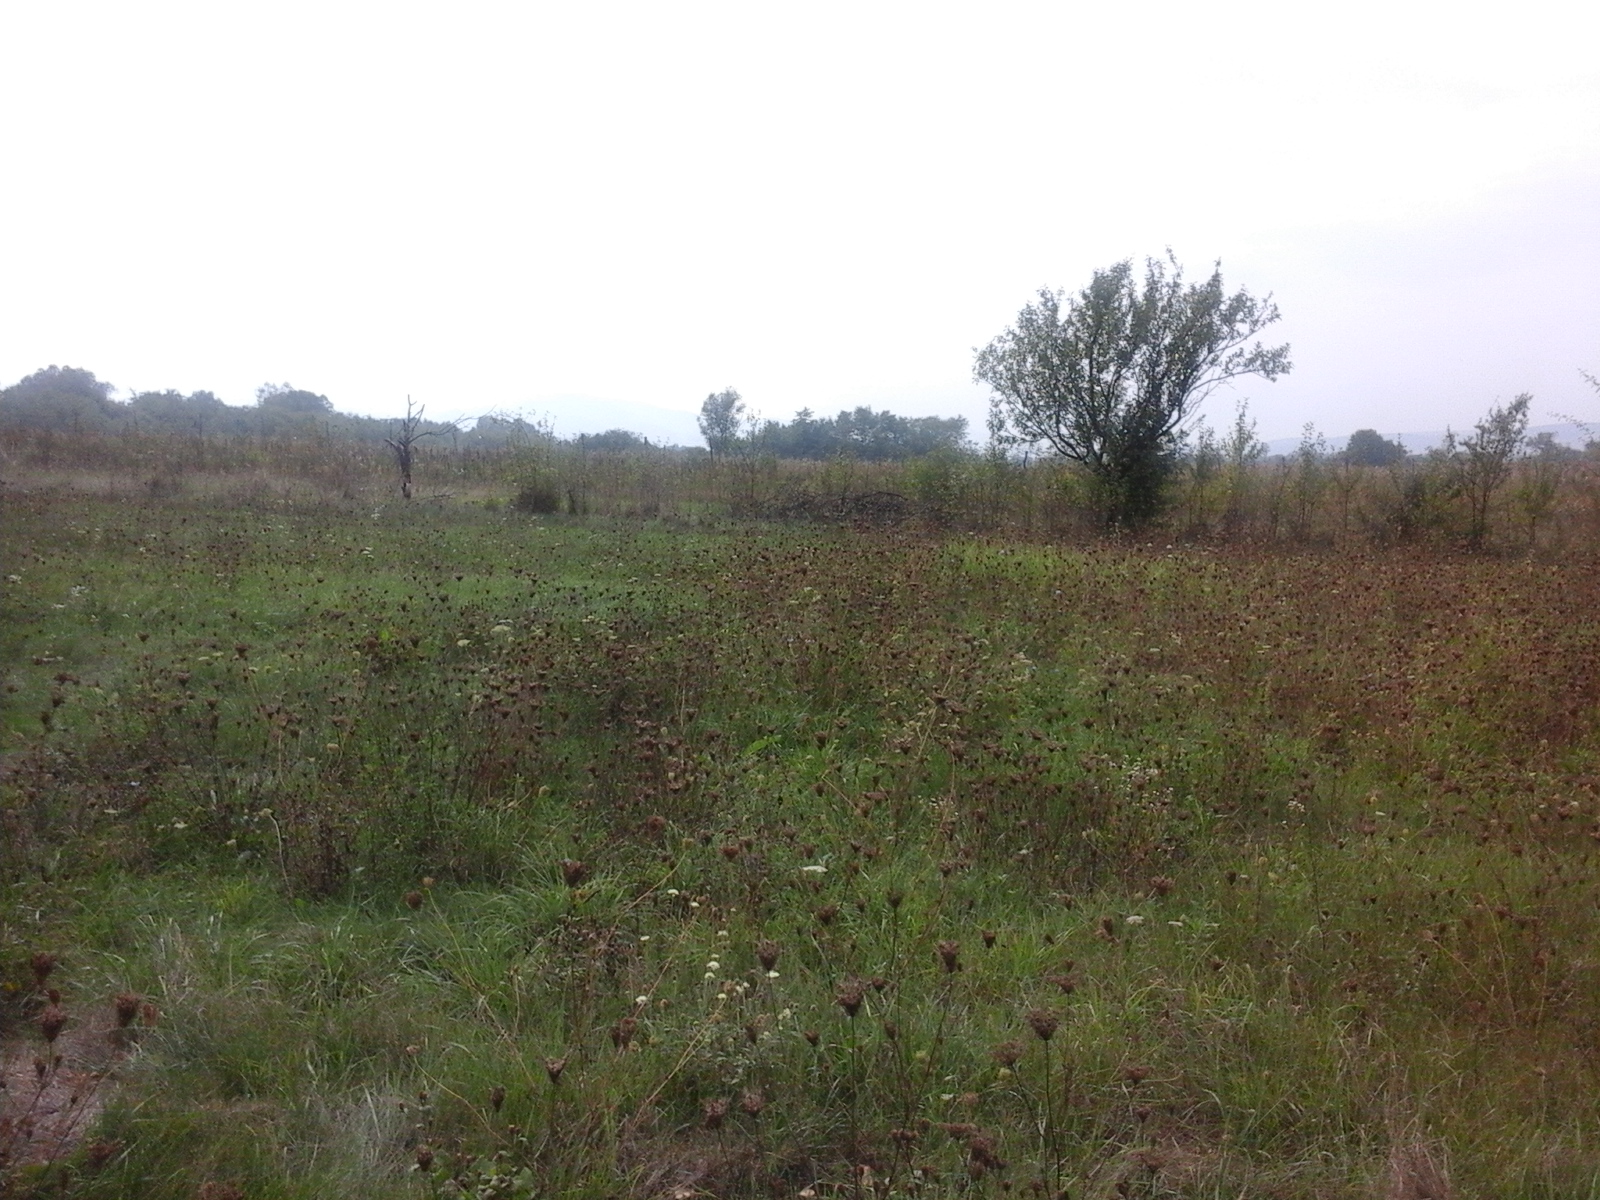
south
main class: Grassland
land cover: Spontaneously vegetated surfaces
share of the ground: > 75 %
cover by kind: herbaceous plants 100 %
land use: Agriculture (excluding fallow land and kitchen gardens)
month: September
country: RO
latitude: 45.7159
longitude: 23.0170
